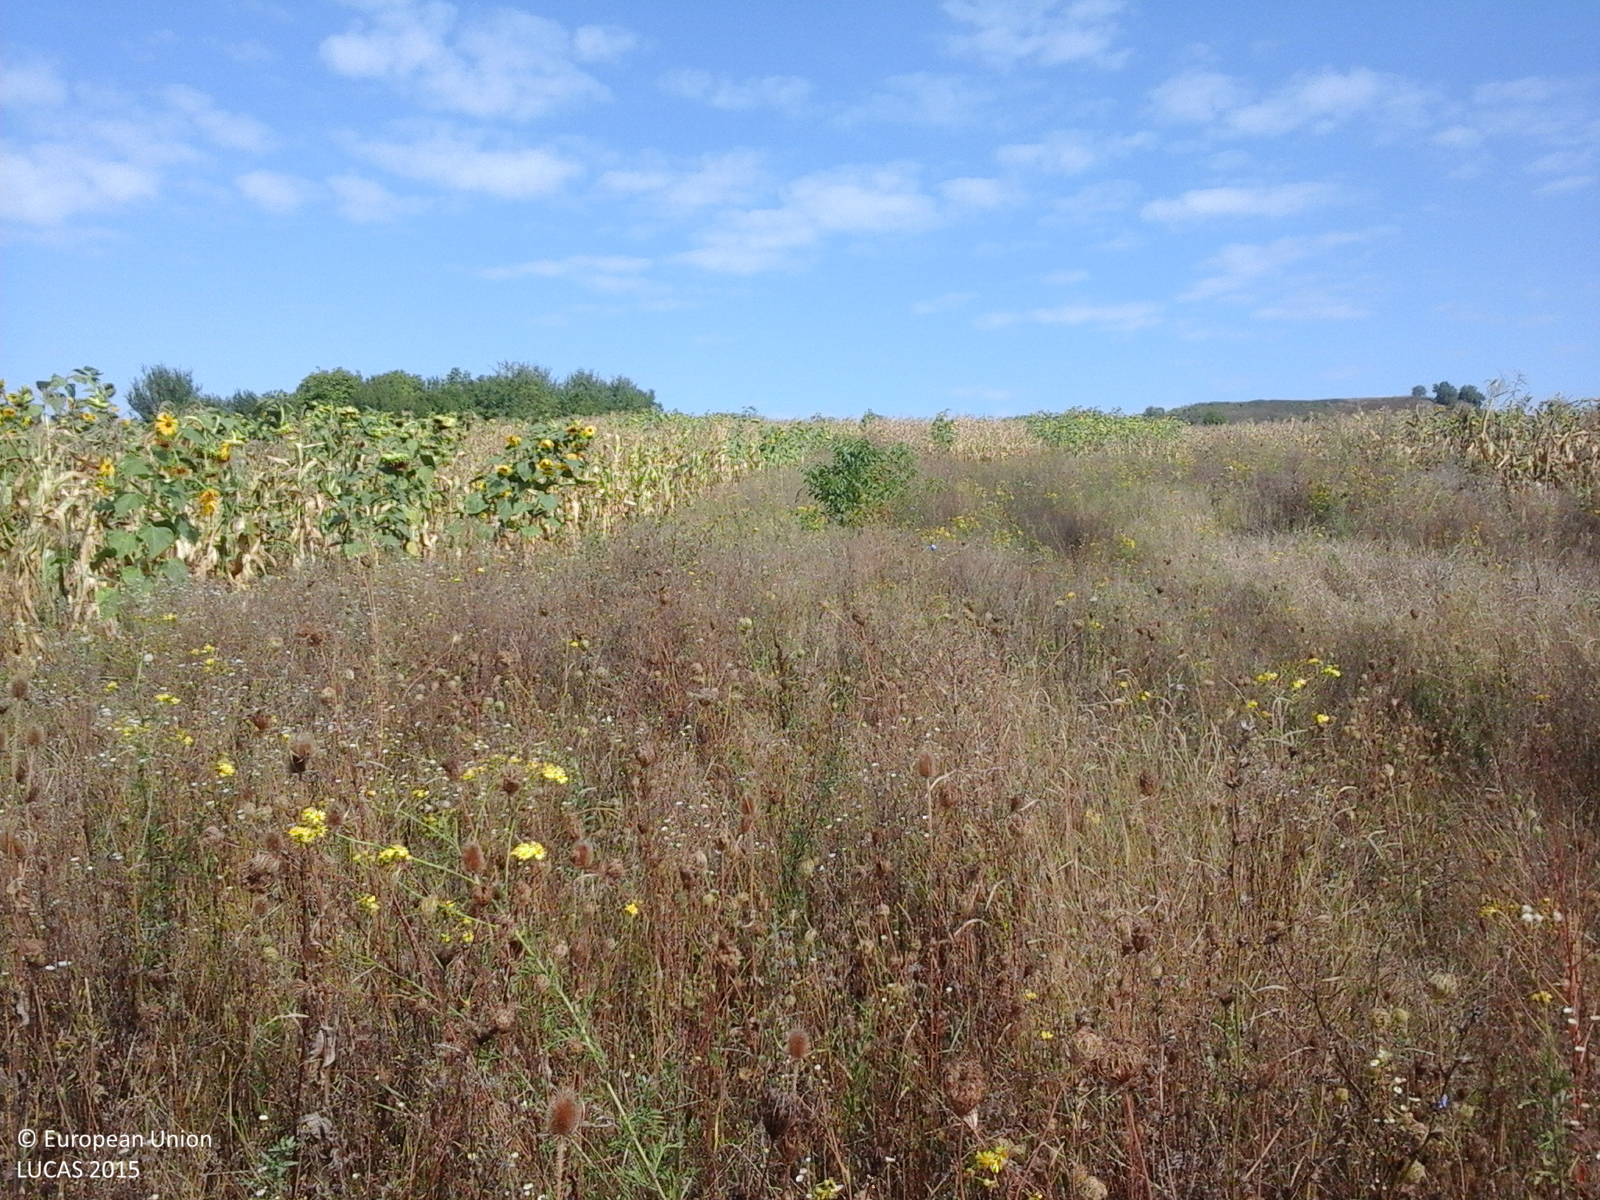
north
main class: Grassland
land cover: Spontaneously vegetated surfaces
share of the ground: > 75 %
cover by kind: herbaceous plants 100 %
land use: Fallow land
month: September
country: RO
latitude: 47.3574
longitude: 23.1608
